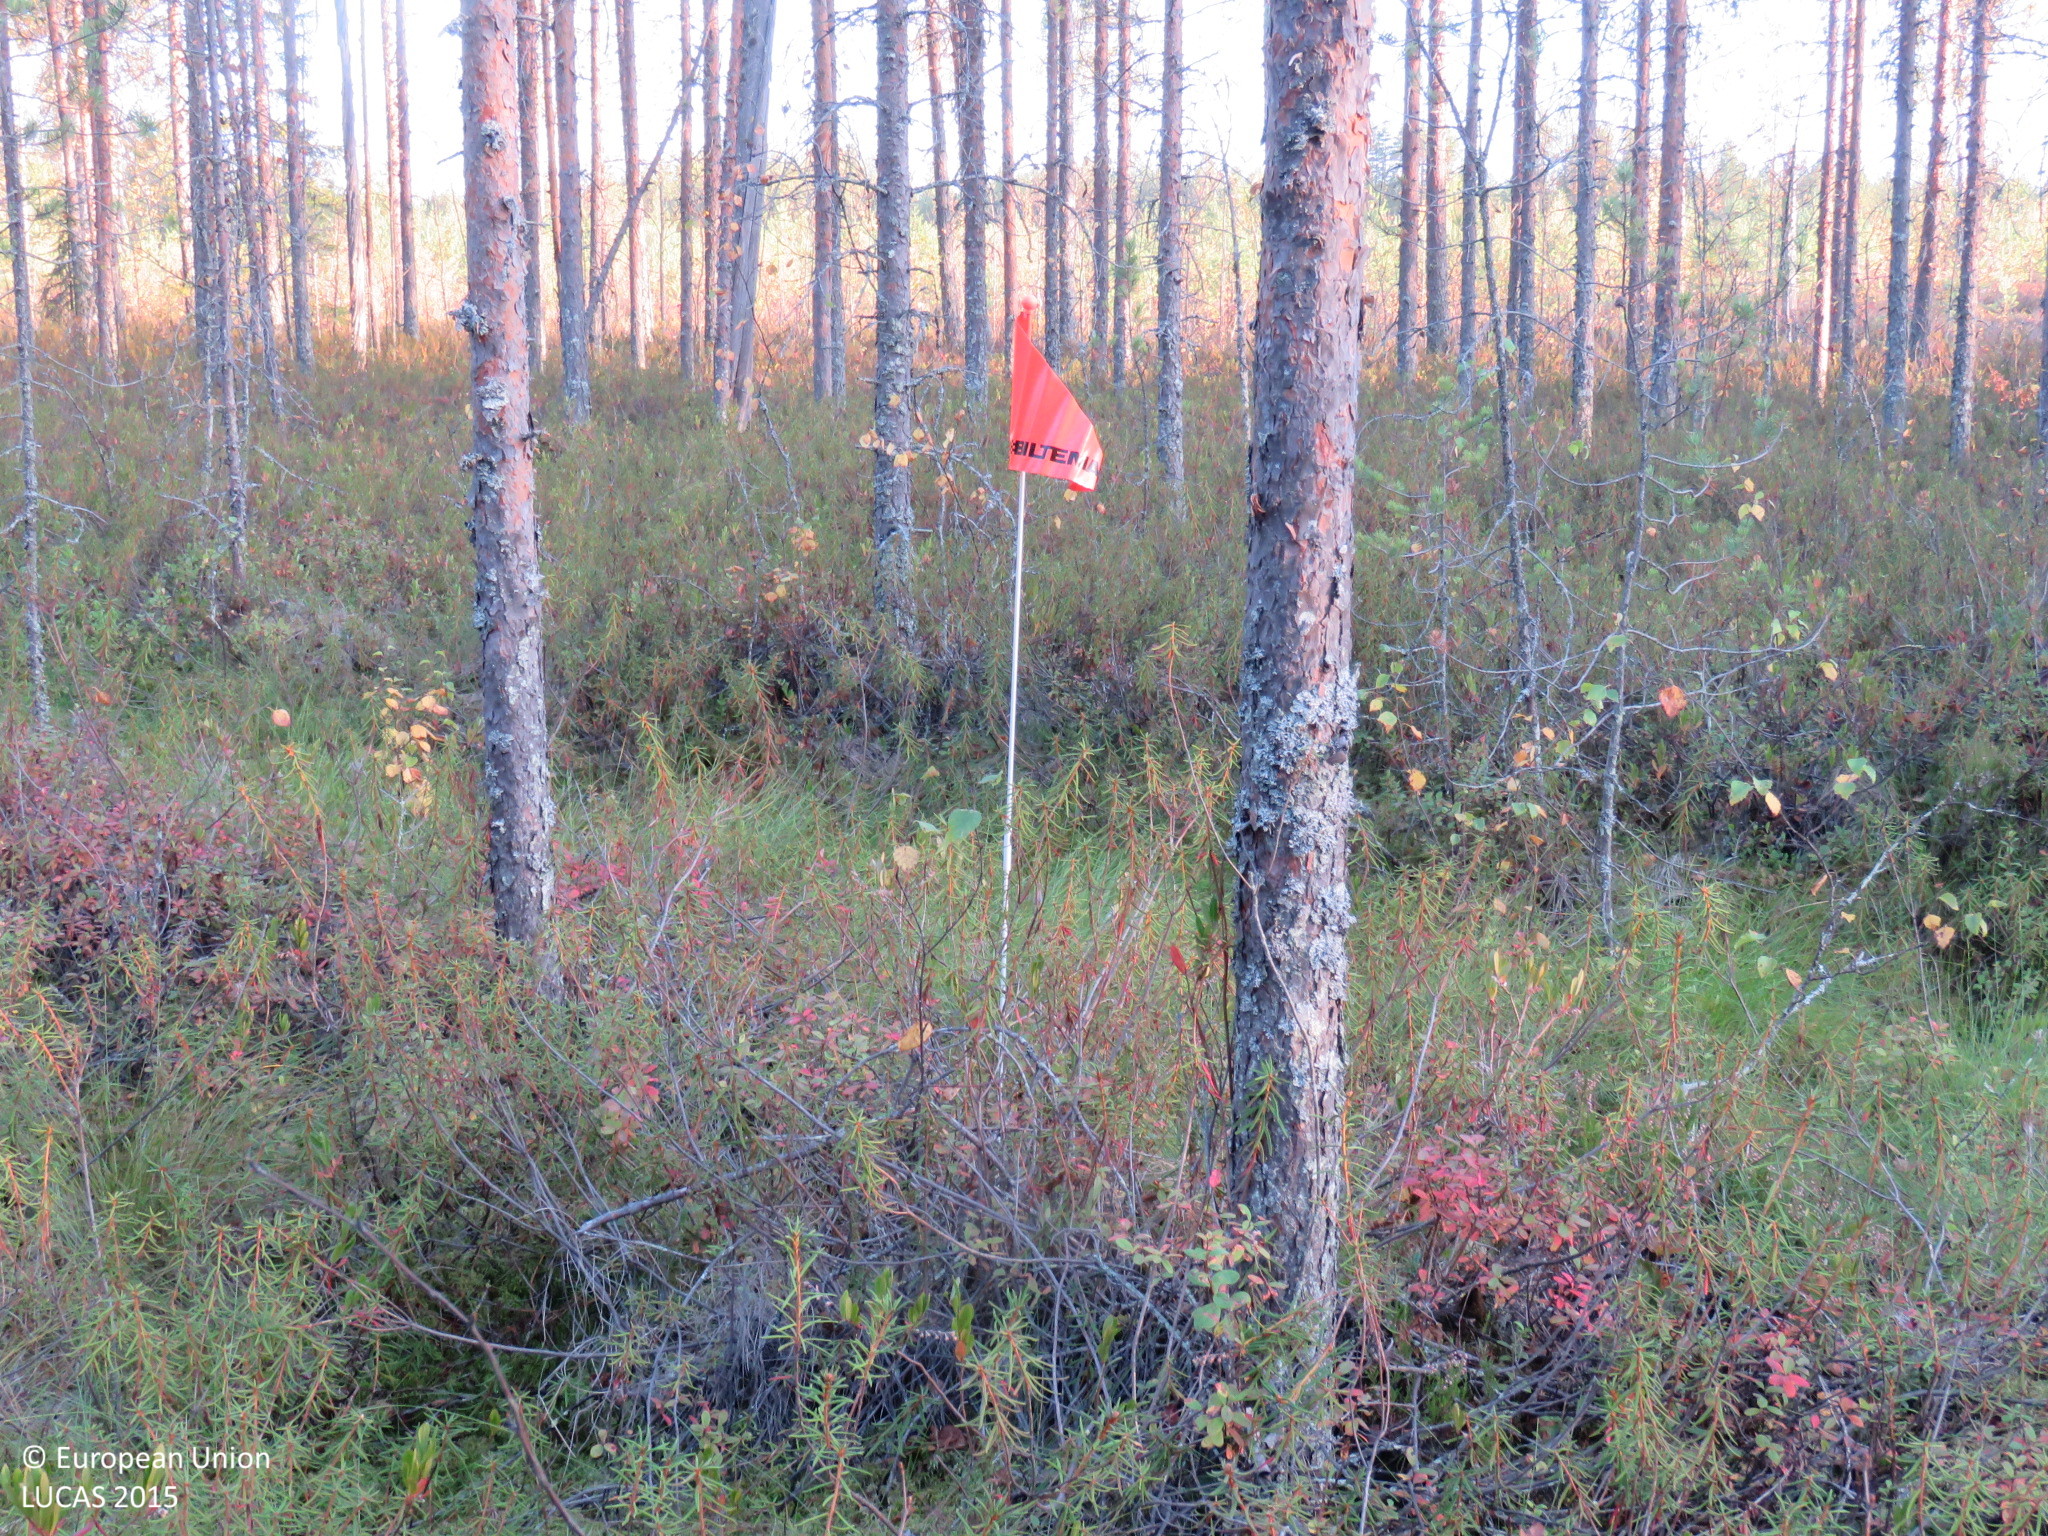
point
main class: Woodland
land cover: Pine dominated coniferous woodland
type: mire and swamp forests
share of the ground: > 75 %
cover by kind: coniferous forest trees 70 %, shrubs 15 %, broadleaved forest trees 5 %, herbaceous plants 5 %, lichens and mosses 5 %
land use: Forestry
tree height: > 5 m
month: September
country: FI
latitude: 65.0354
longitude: 26.7845
